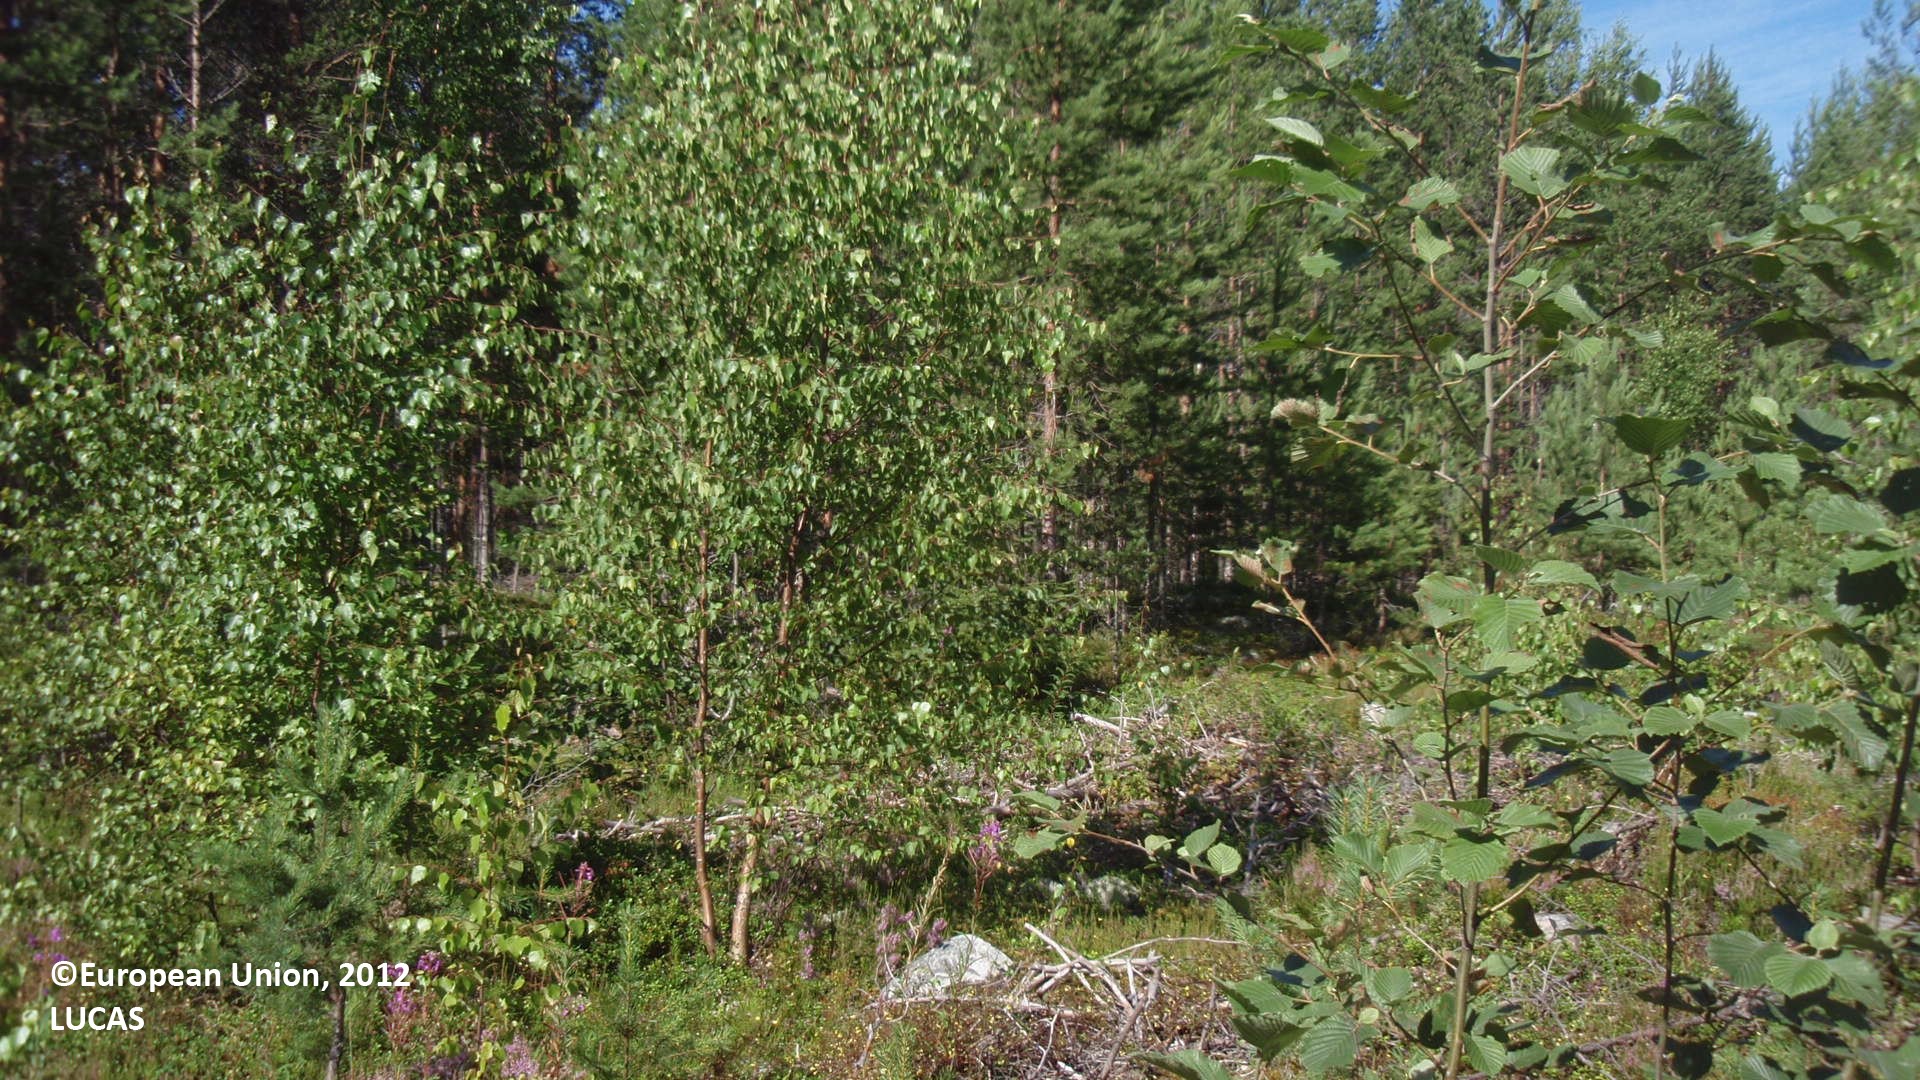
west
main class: Grassland
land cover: Grassland with sparse tree/shrub cover
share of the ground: > 75 %
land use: Forestry
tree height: > 5 m
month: July
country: FI
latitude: 61.4212
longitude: 28.1332
